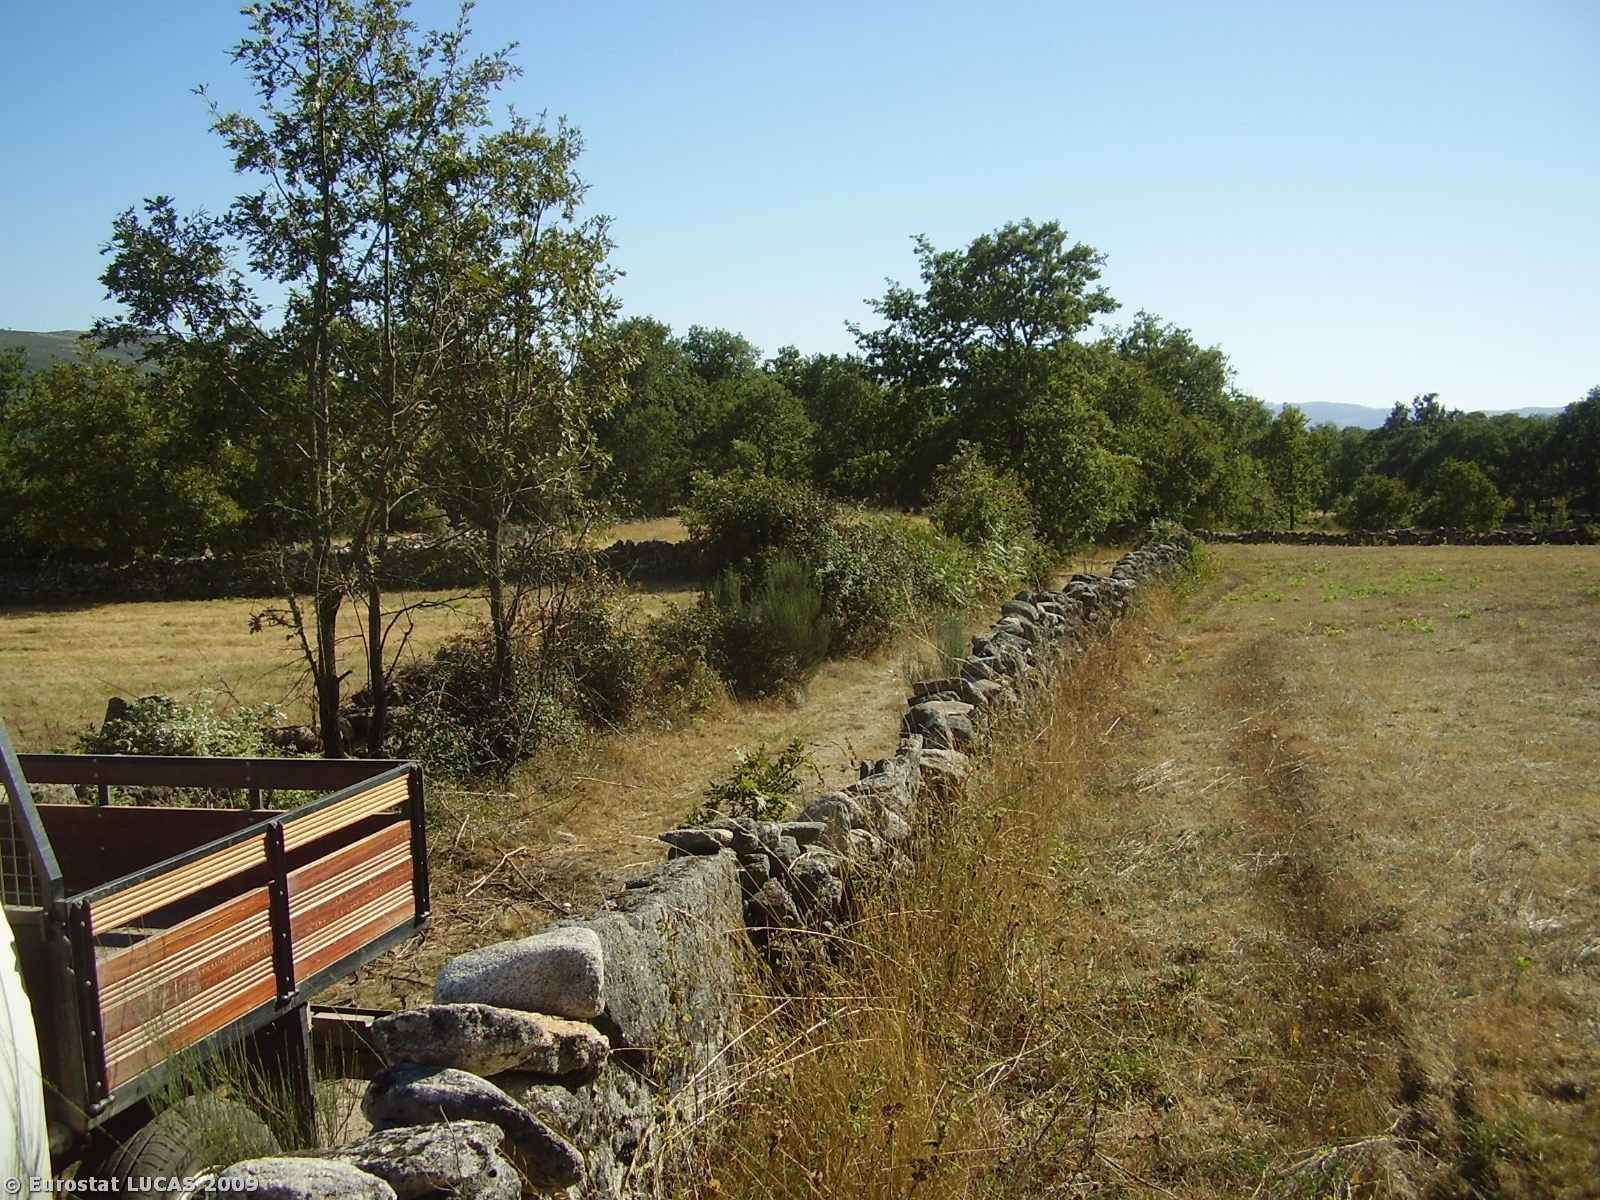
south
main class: Grassland
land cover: Grassland without tree/shrub cover
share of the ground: > 75 %
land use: Fallow land
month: September
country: PT
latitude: 41.7696
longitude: -7.6627
